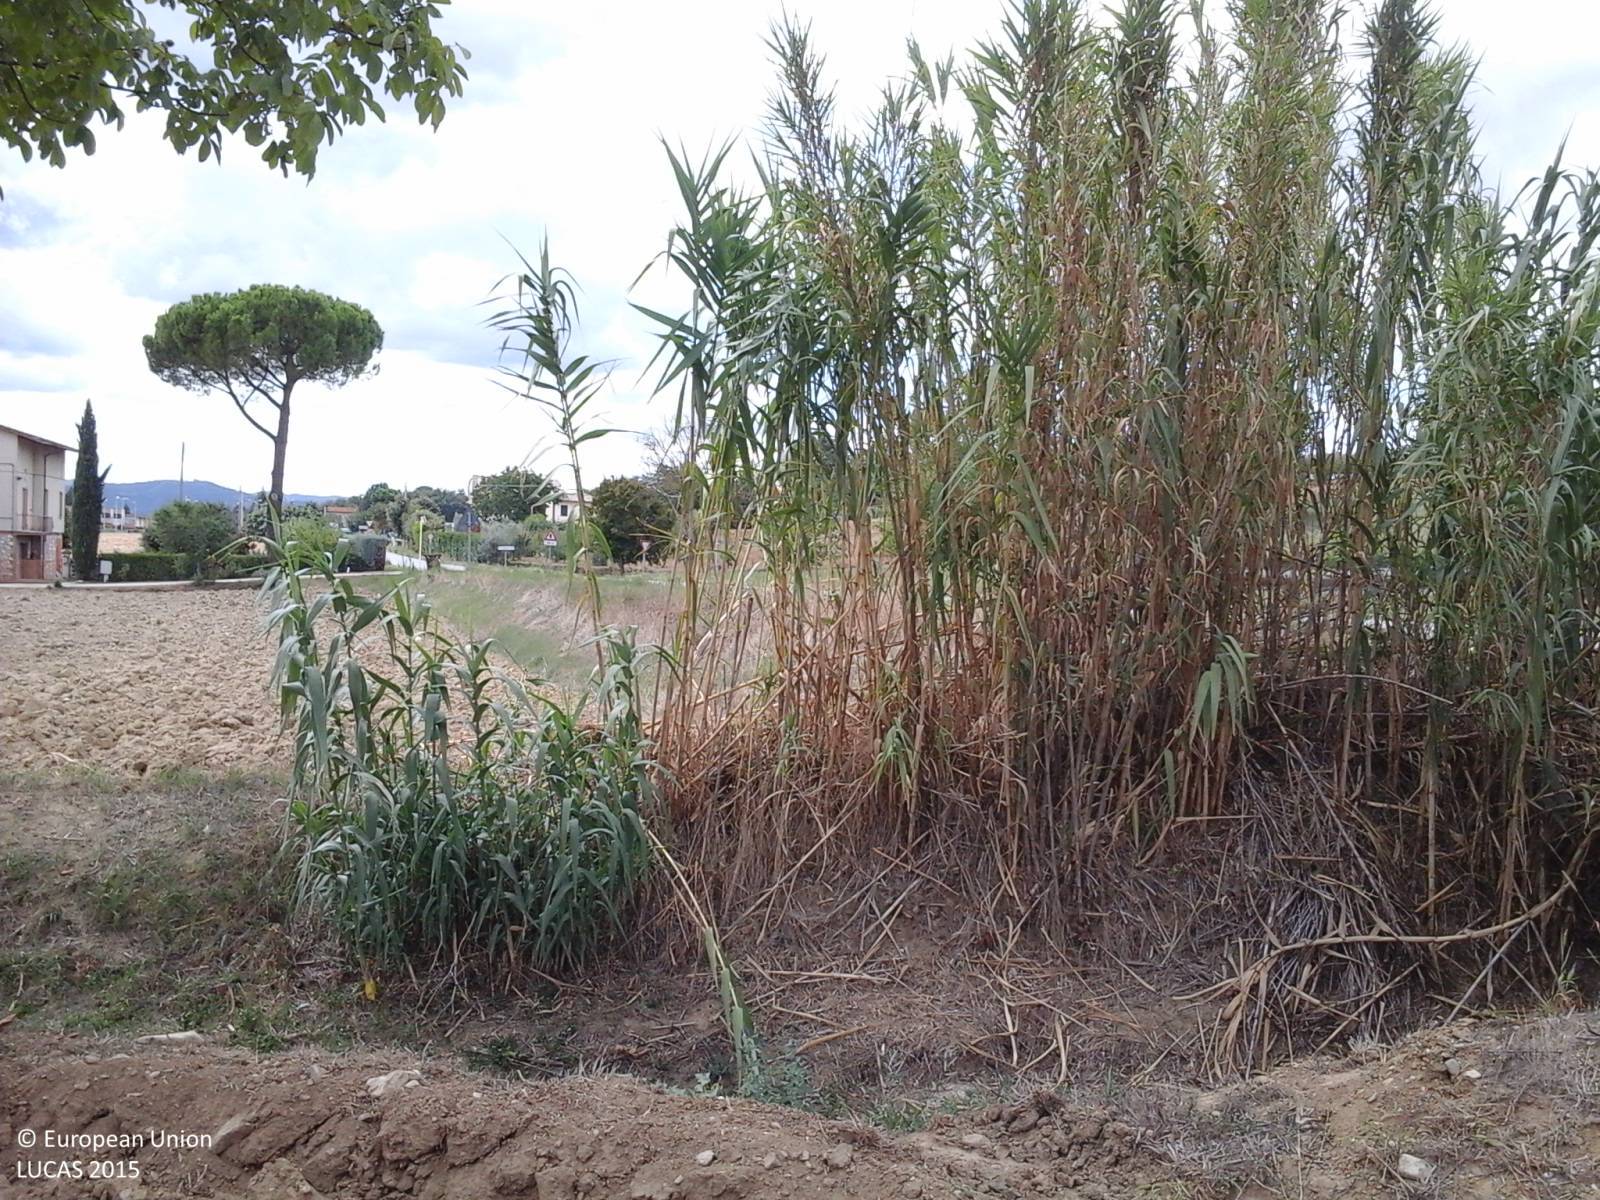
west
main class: Cropland
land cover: Barley
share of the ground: < 10 %
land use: Agriculture (excluding fallow land and kitchen gardens)
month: September
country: IT
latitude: 42.9326
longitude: 12.4067
